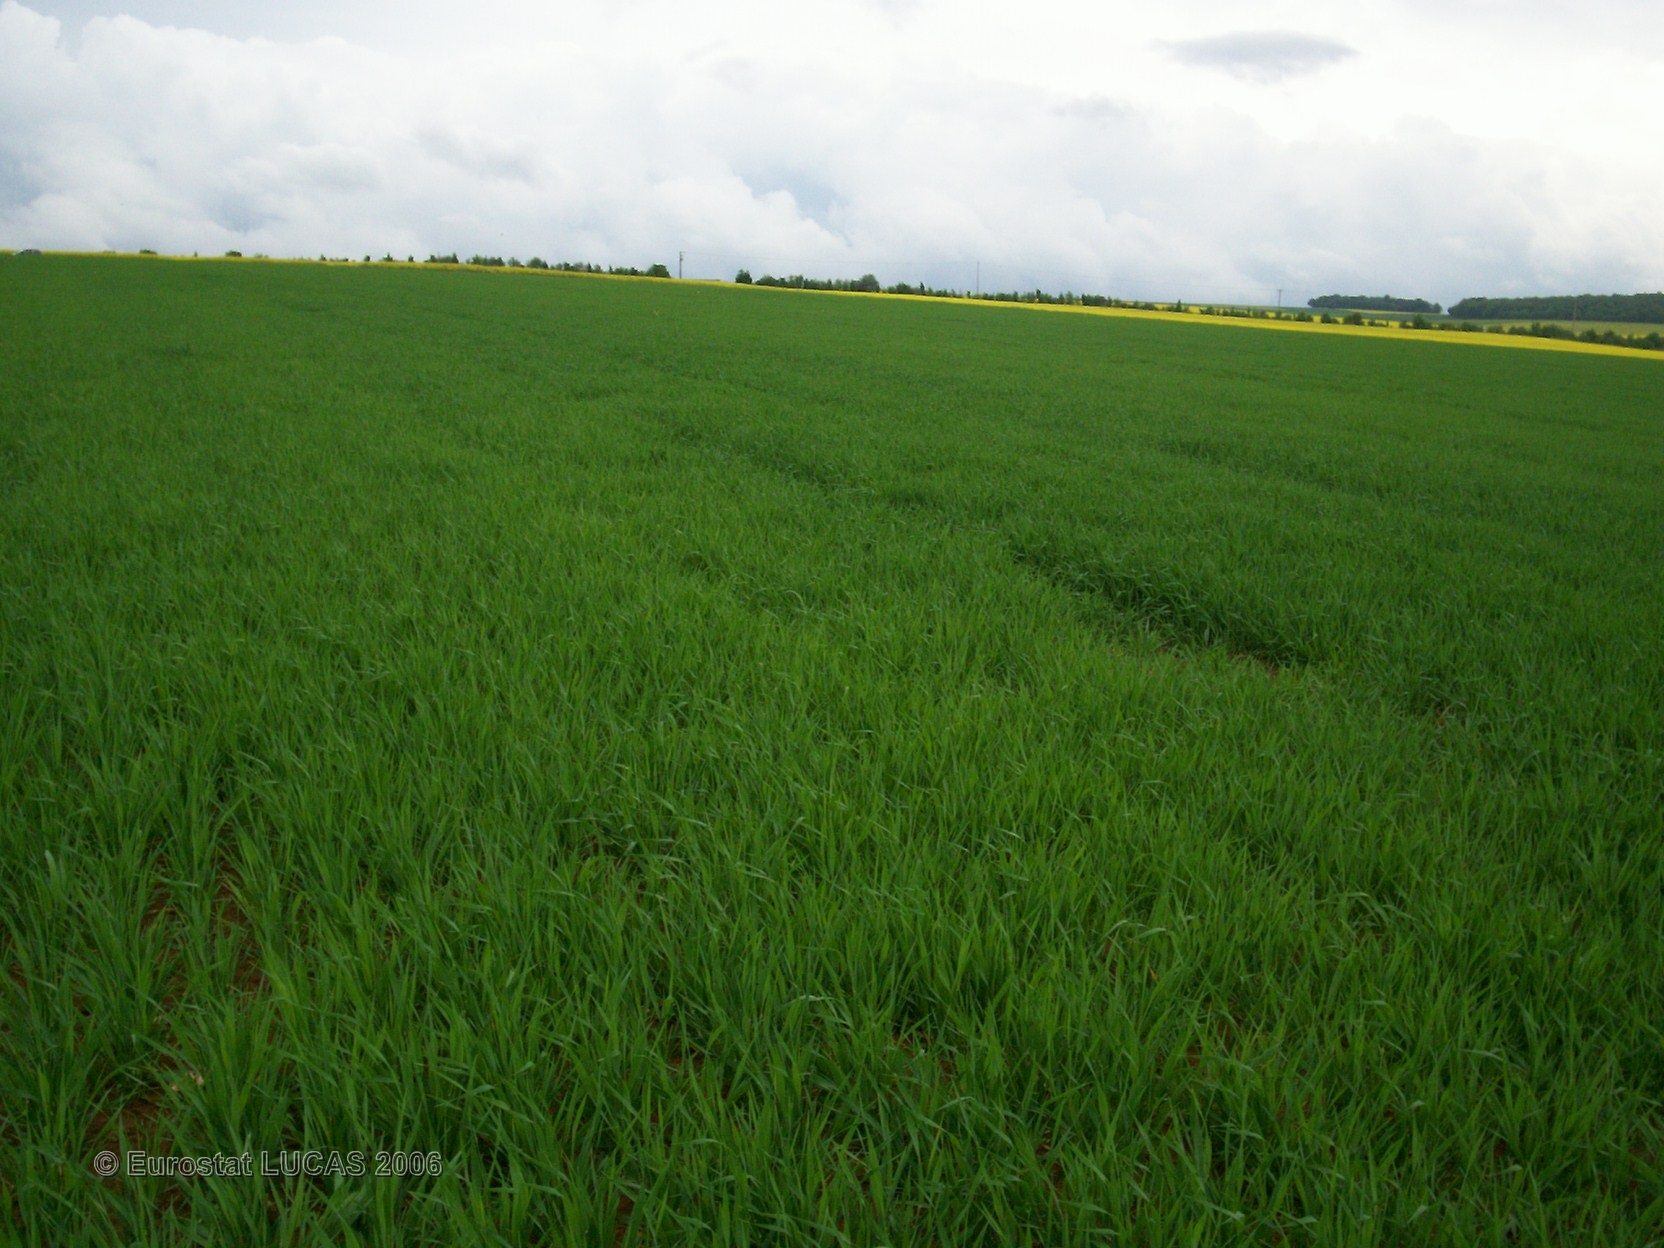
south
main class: Cropland
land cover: Barley
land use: Agriculture (excluding fallow land and kitchen gardens)
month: May
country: FR
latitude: 48.1750
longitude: 4.4705
